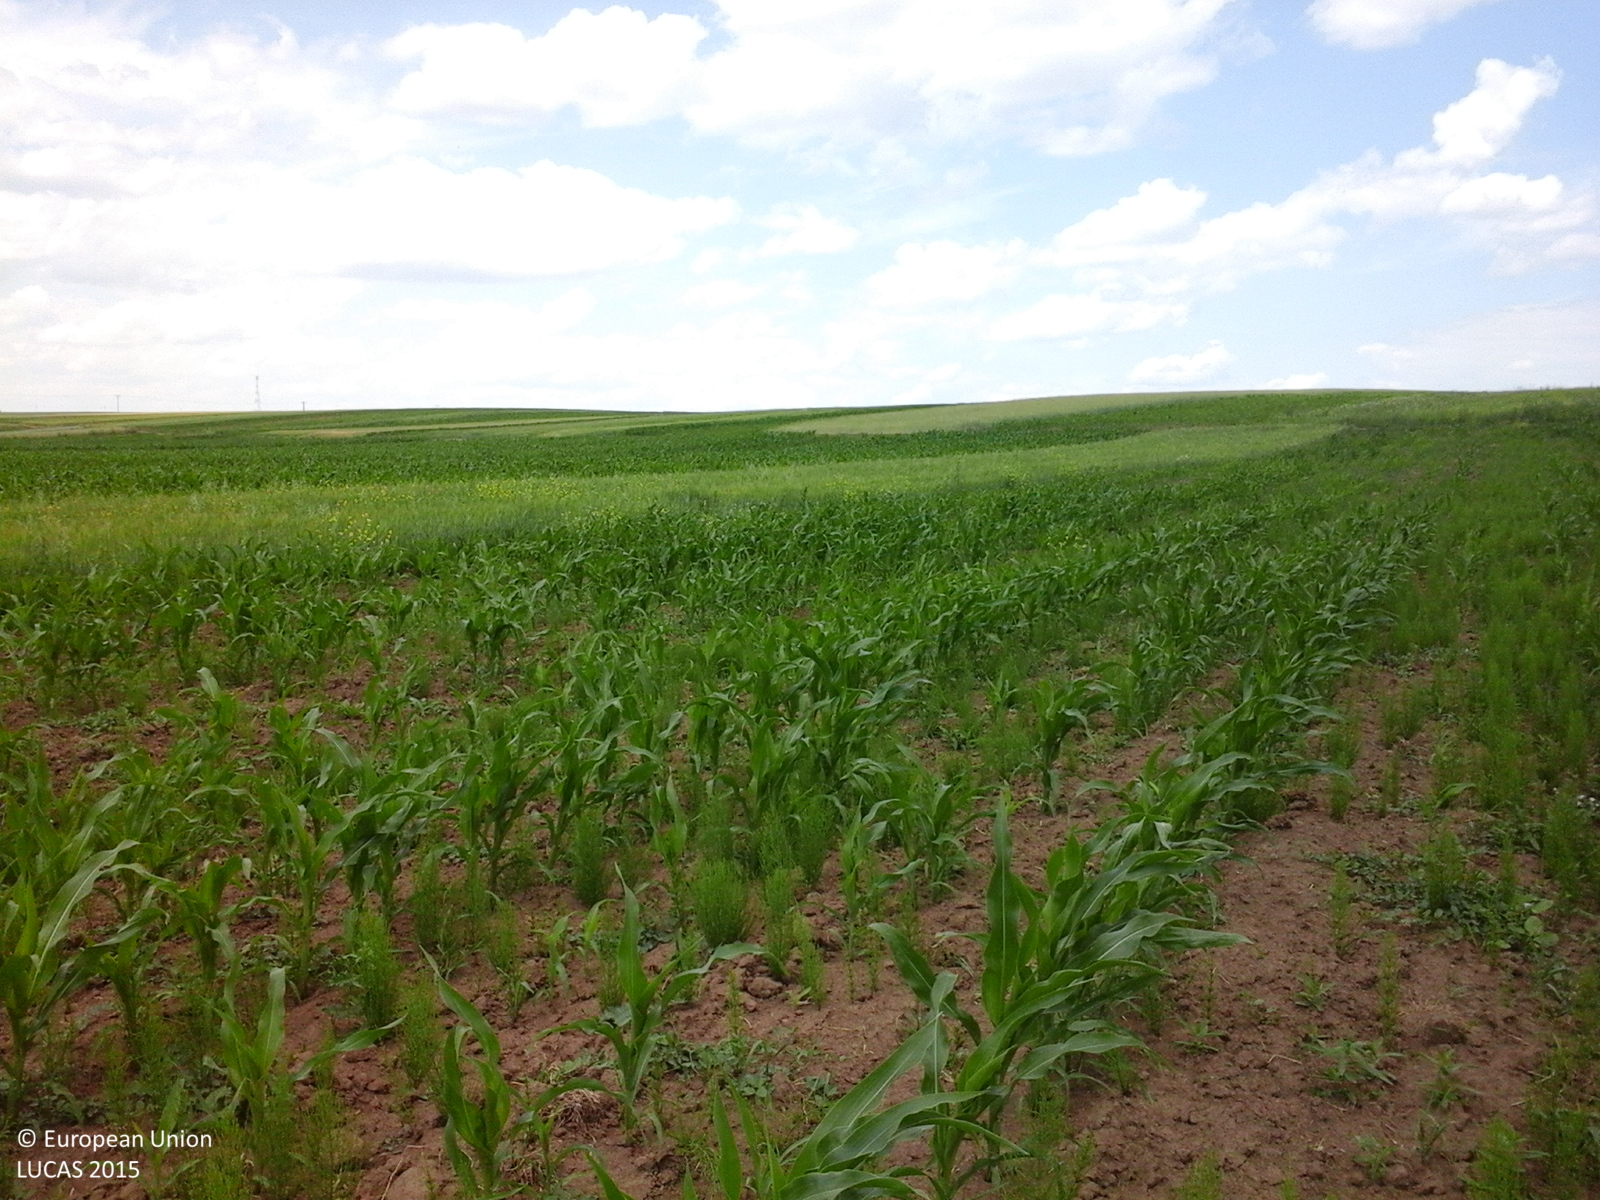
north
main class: Cropland
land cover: Maize
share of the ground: 50 - 75 %
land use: Agriculture (excluding fallow land and kitchen gardens)
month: June
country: RO
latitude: 47.6325
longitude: 26.3624
